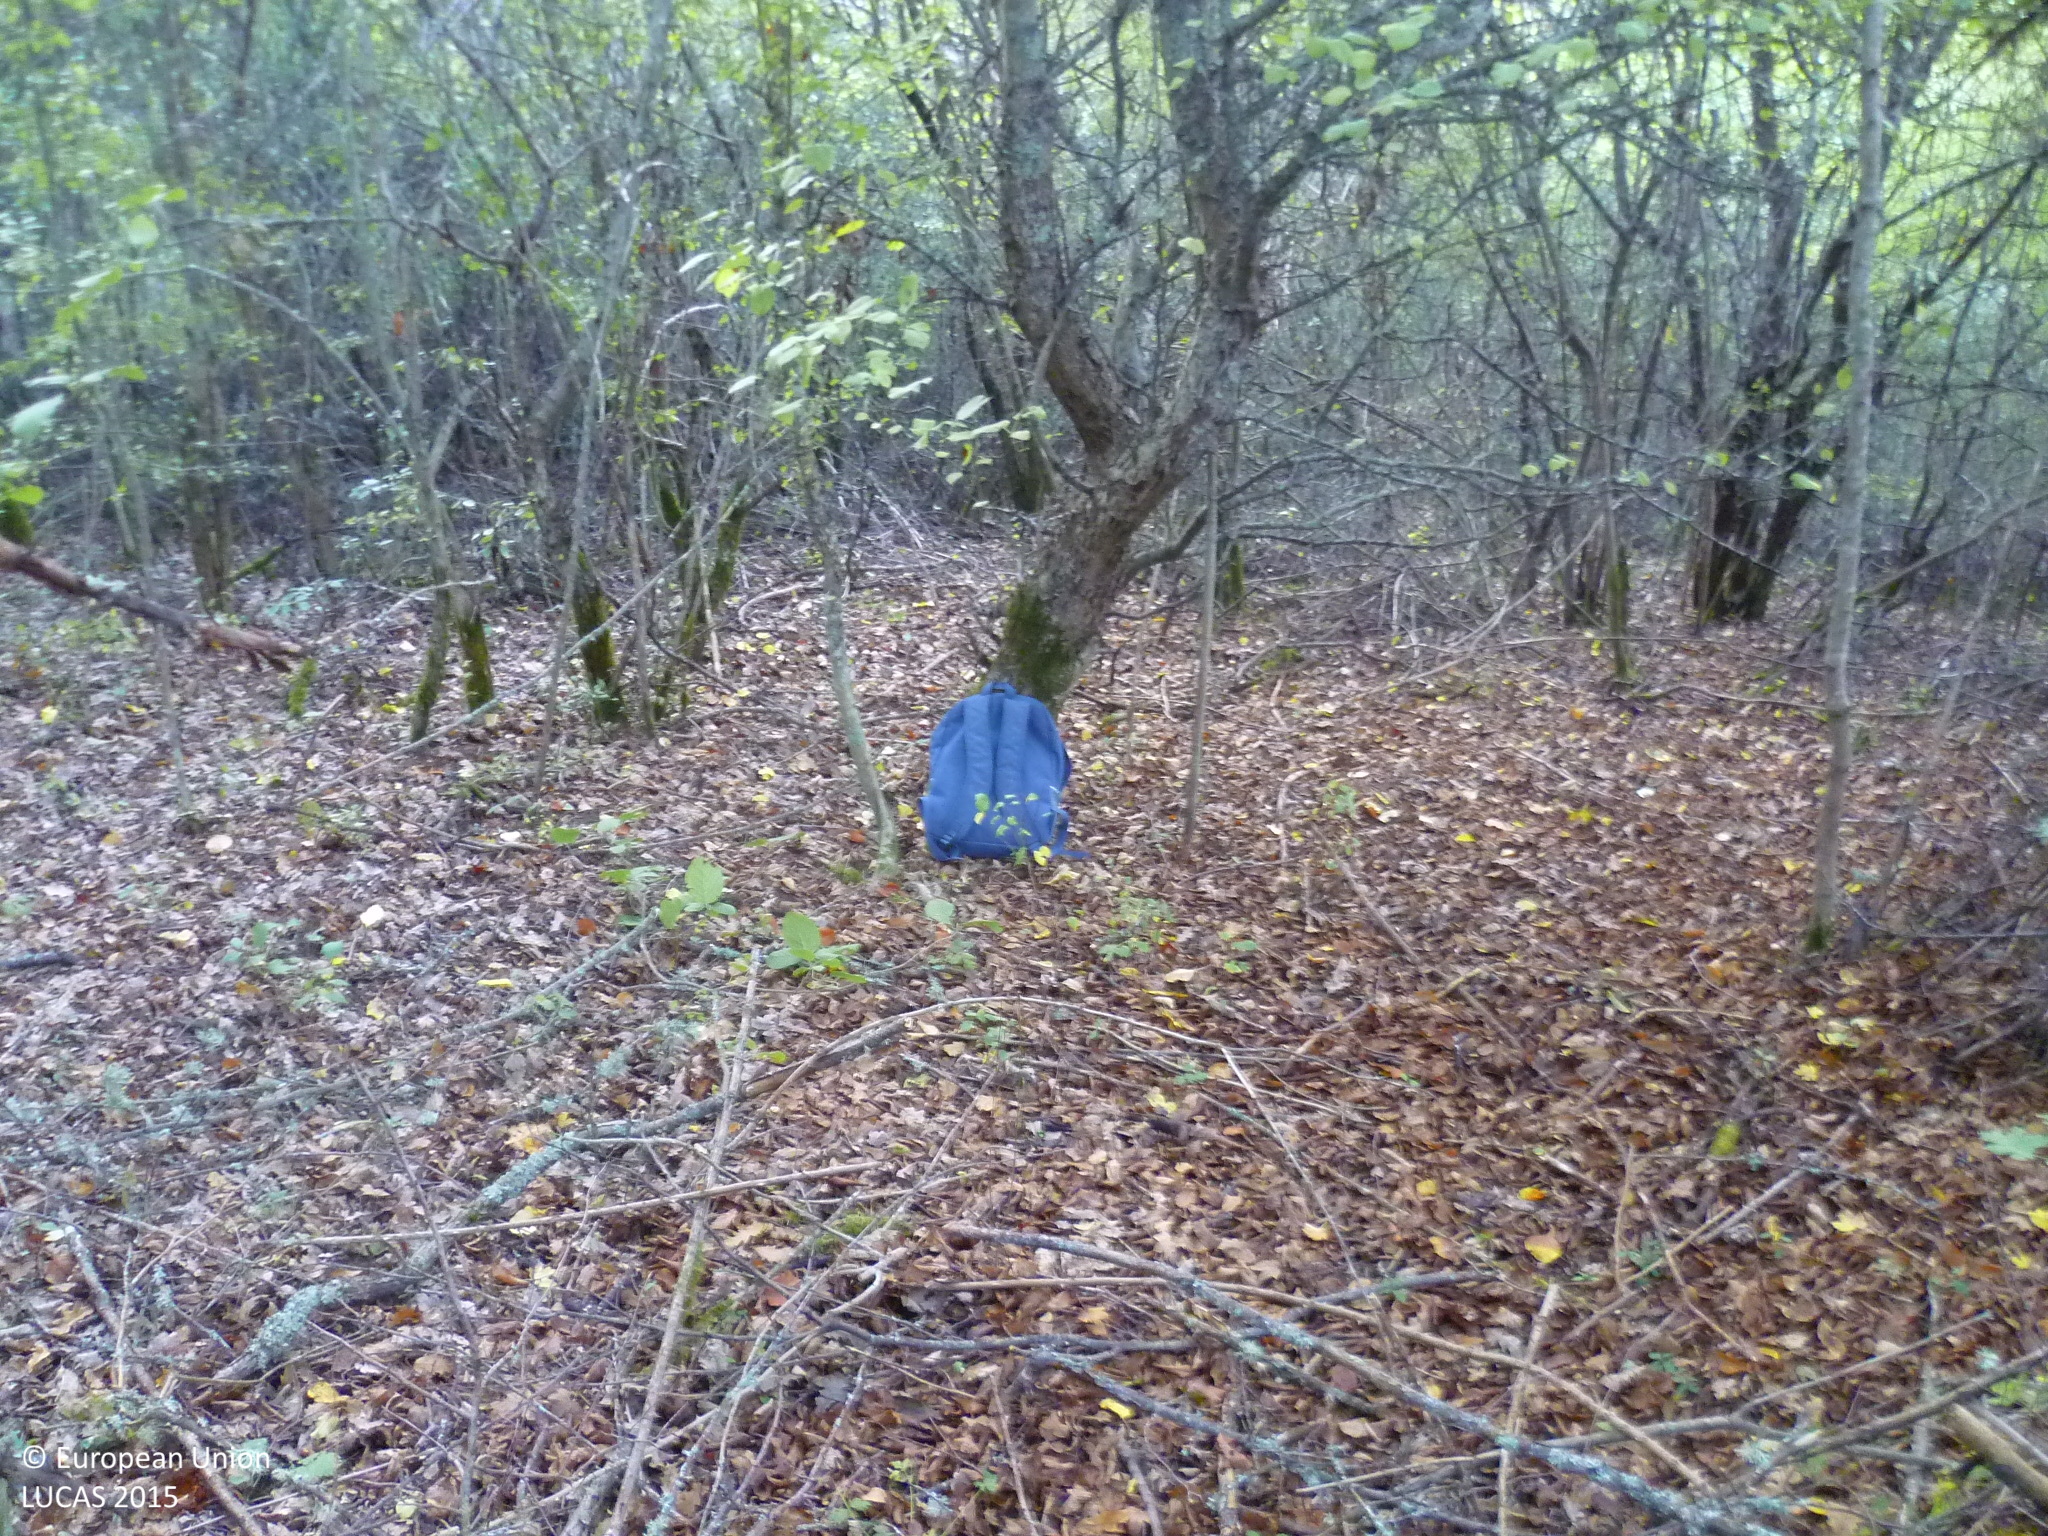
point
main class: Woodland
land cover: Broadleaved woodland
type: mesophytic deciduous forest
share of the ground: 50 - 75 %
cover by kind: broadleaved forest trees 60 %, unconsolidated bare surface 30 %, shrubs 5 %, lichens and mosses 5 %
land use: Forestry
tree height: > 5 m
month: October
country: BG
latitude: 42.8234
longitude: 22.6619
